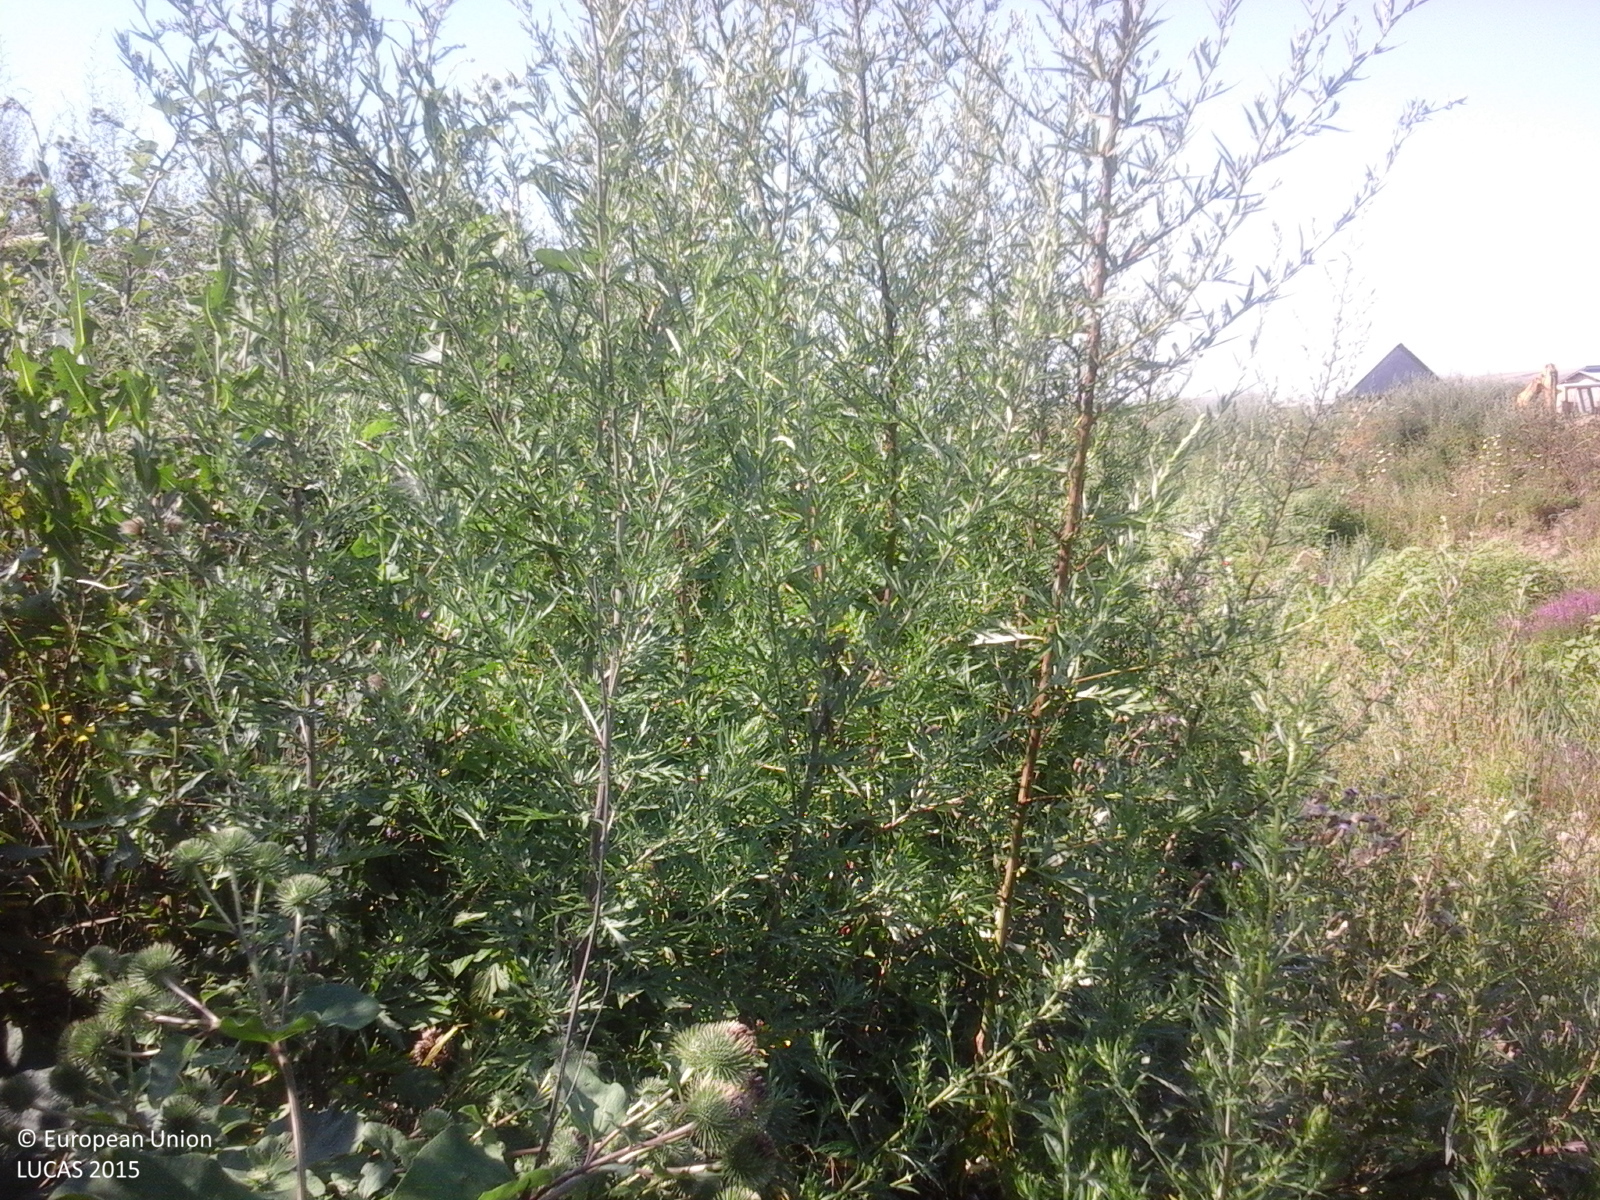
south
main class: Grassland
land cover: Spontaneously vegetated surfaces
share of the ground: > 75 %
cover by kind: herbaceous plants 100 %
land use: Semi-natural and natural areas not in use
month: July
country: RO
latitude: 44.3247
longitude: 24.5536
